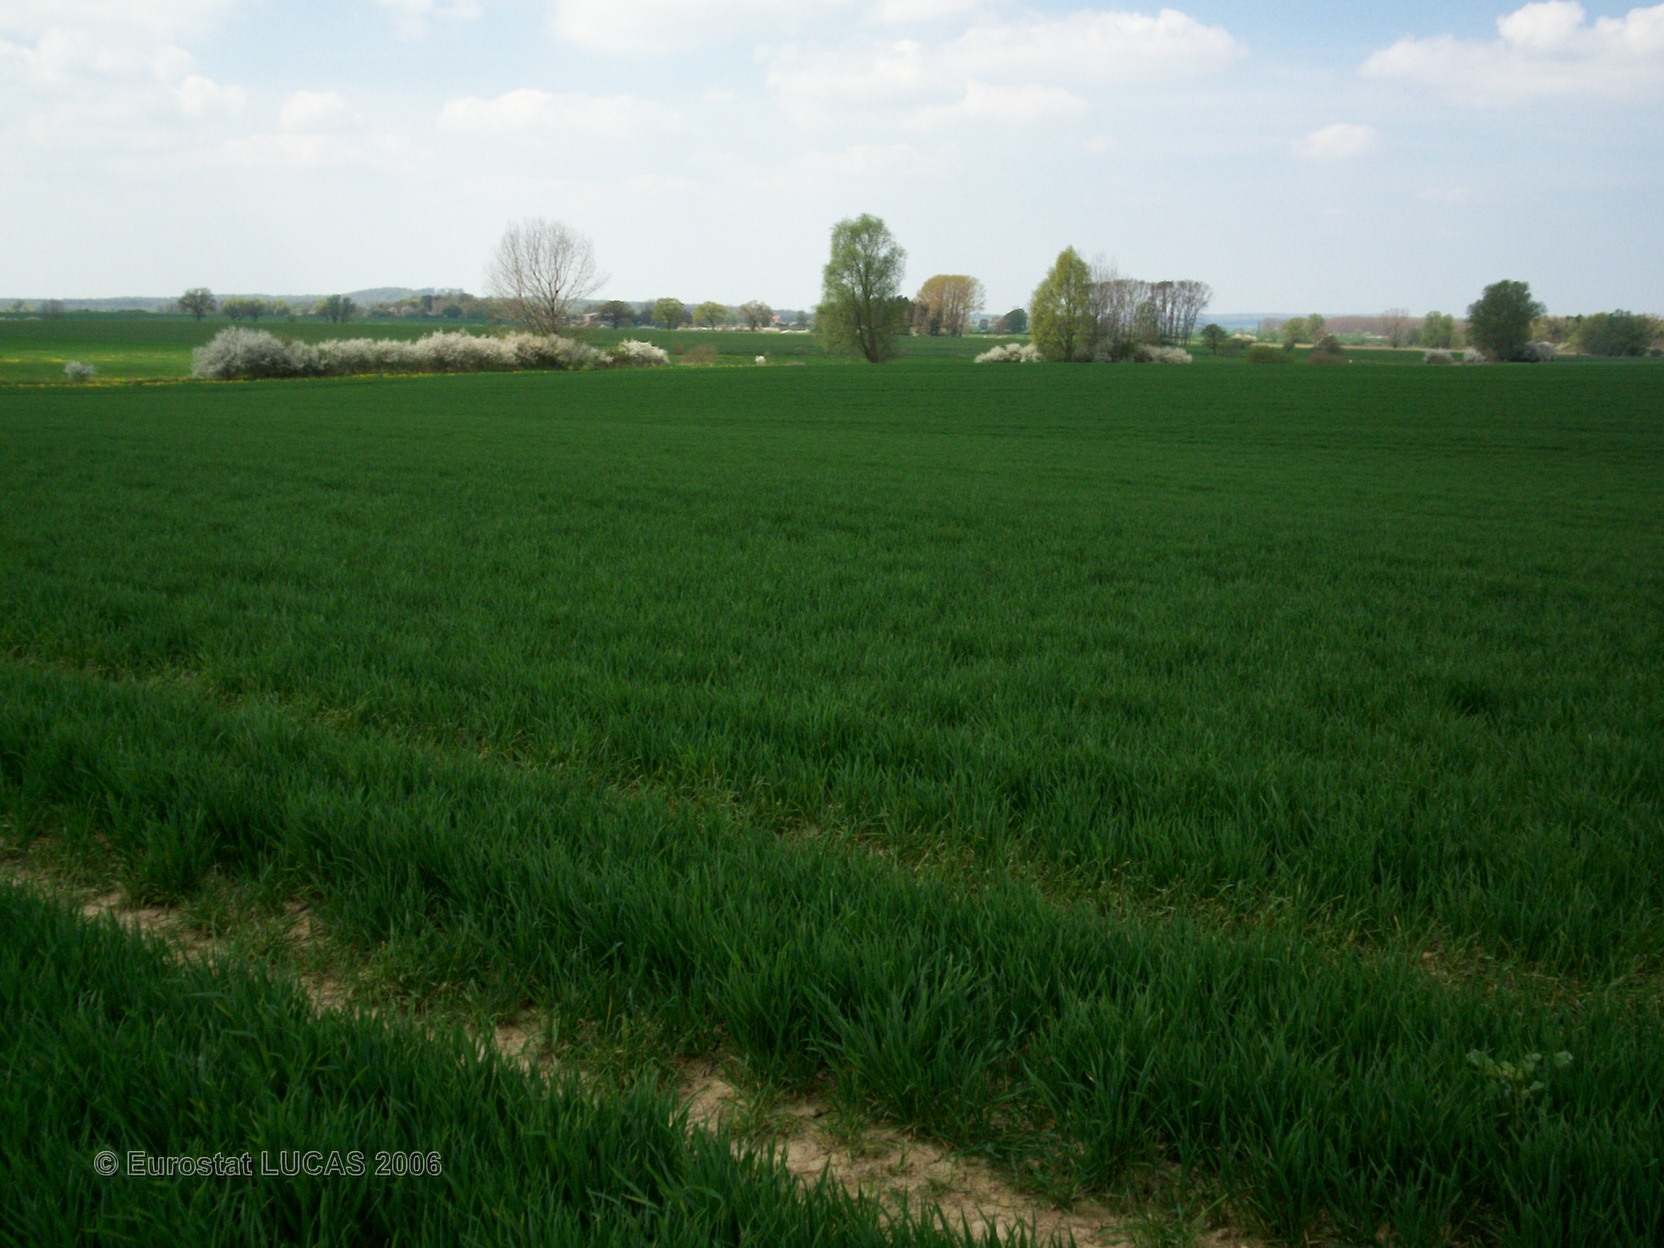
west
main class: Cropland
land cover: Common wheat
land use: Agriculture (excluding fallow land and kitchen gardens)
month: April
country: FR
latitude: 49.0035
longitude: 6.7332
